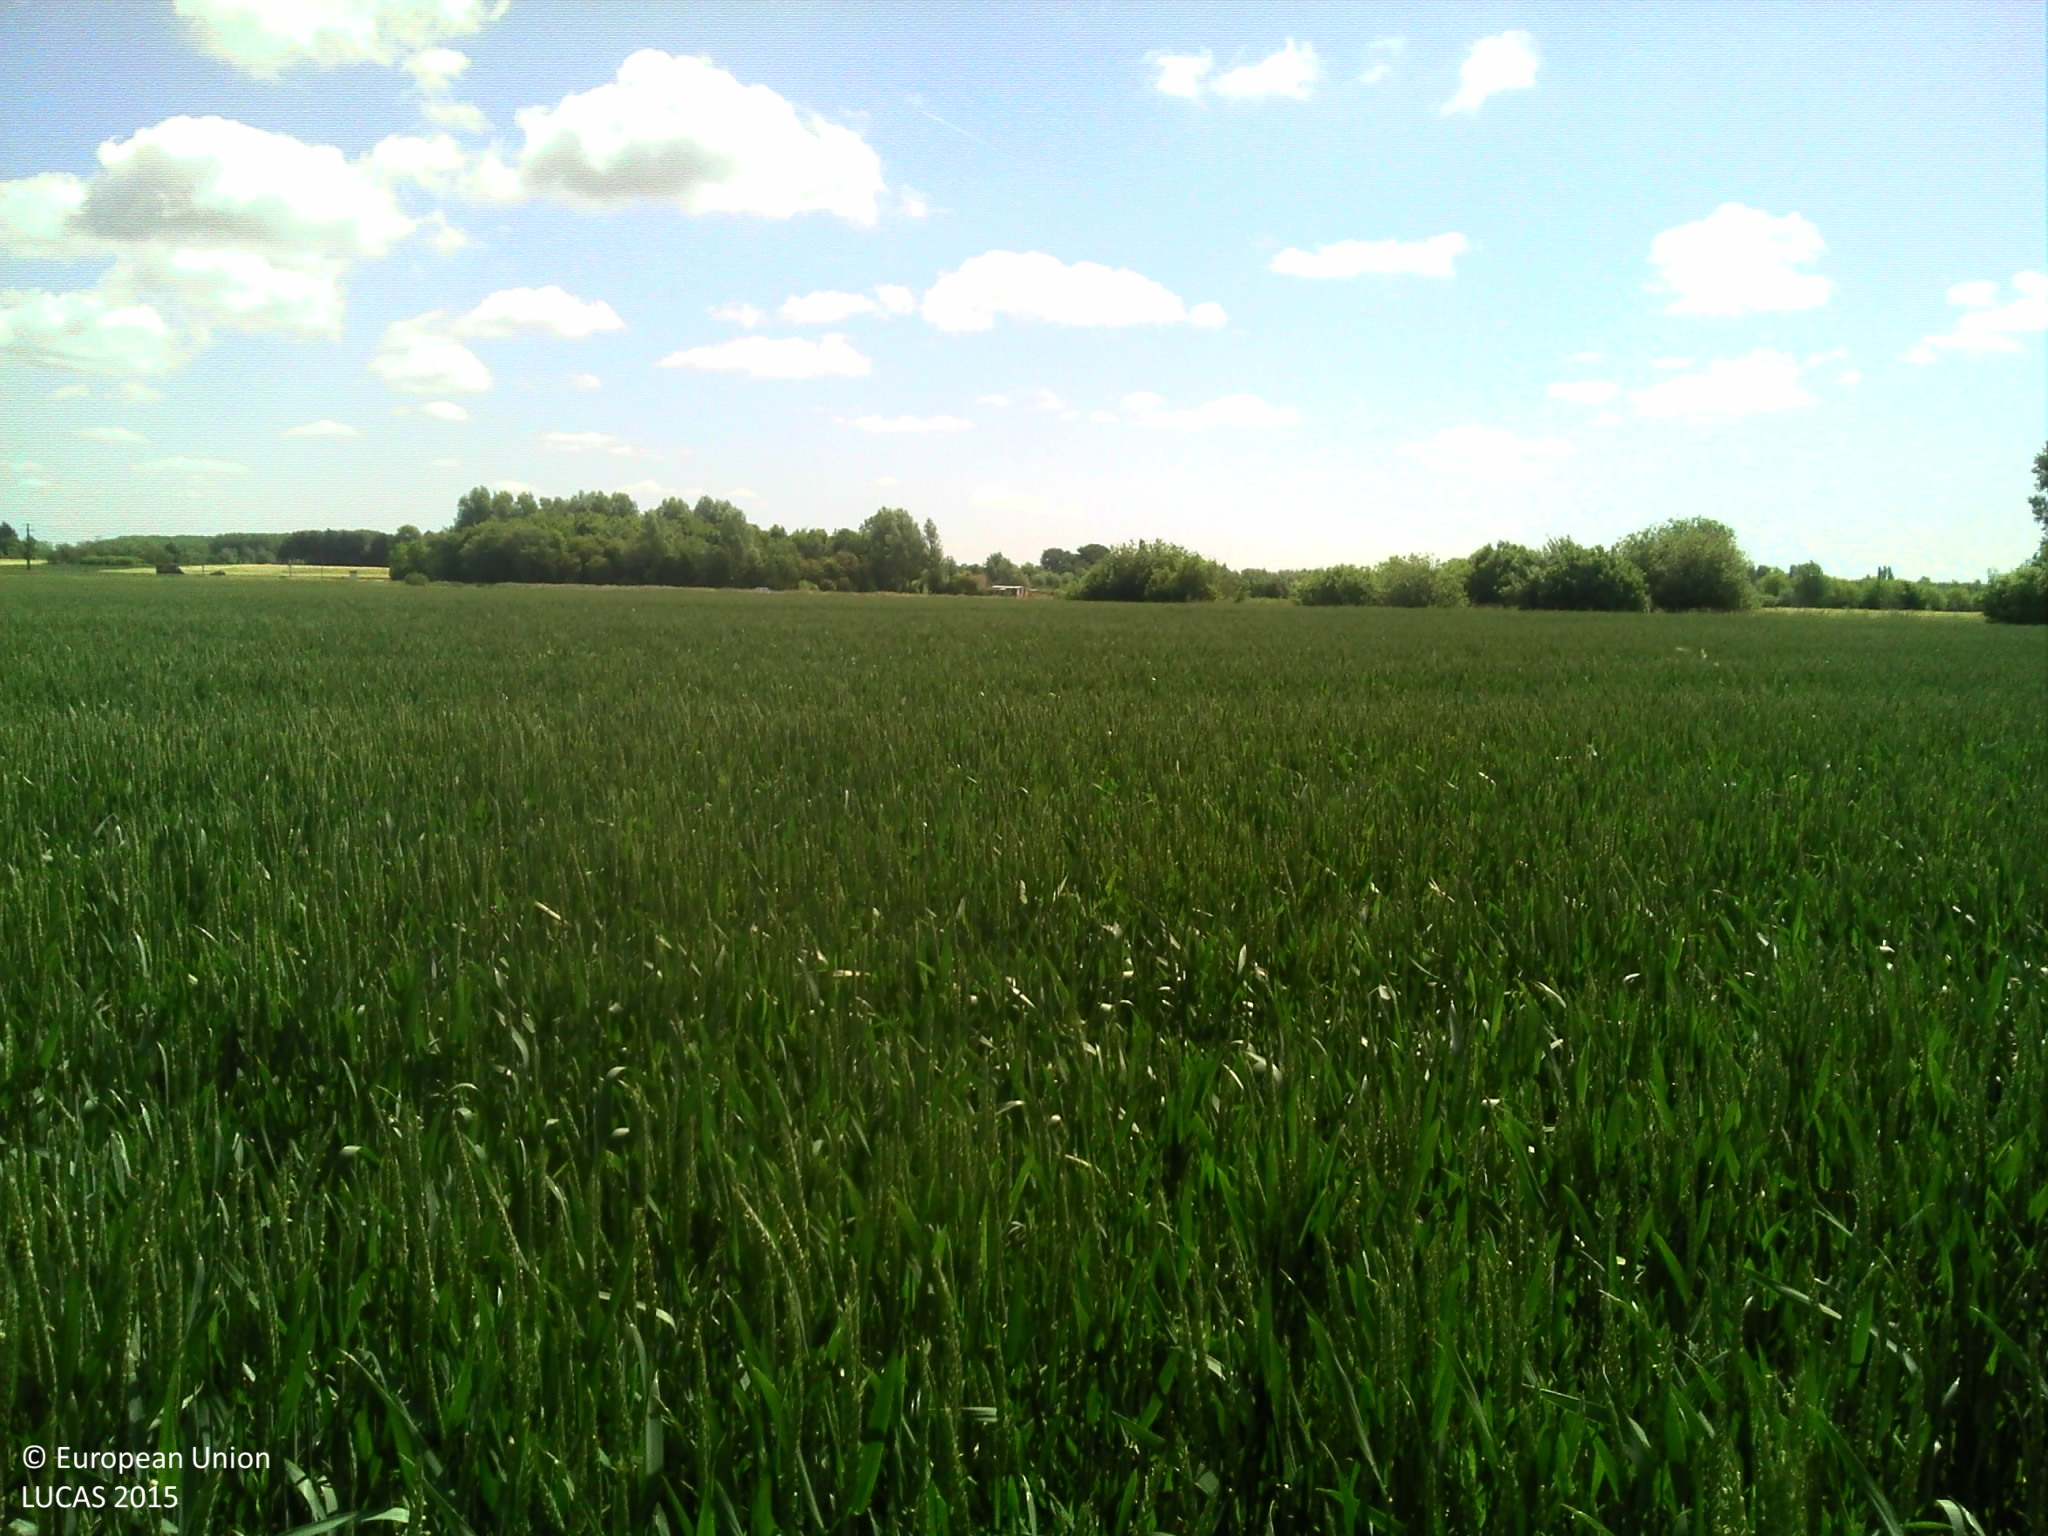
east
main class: Cropland
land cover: Common wheat
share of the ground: > 75 %
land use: Agriculture (excluding fallow land and kitchen gardens)
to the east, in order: Common wheat; Maize; Grass margins; Ditches and canals; Grass margins; Tracks; Grass margins; Ditches and canals; Grass margins; Sugar beet
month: June
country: FR
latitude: 50.3098
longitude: 1.6269
